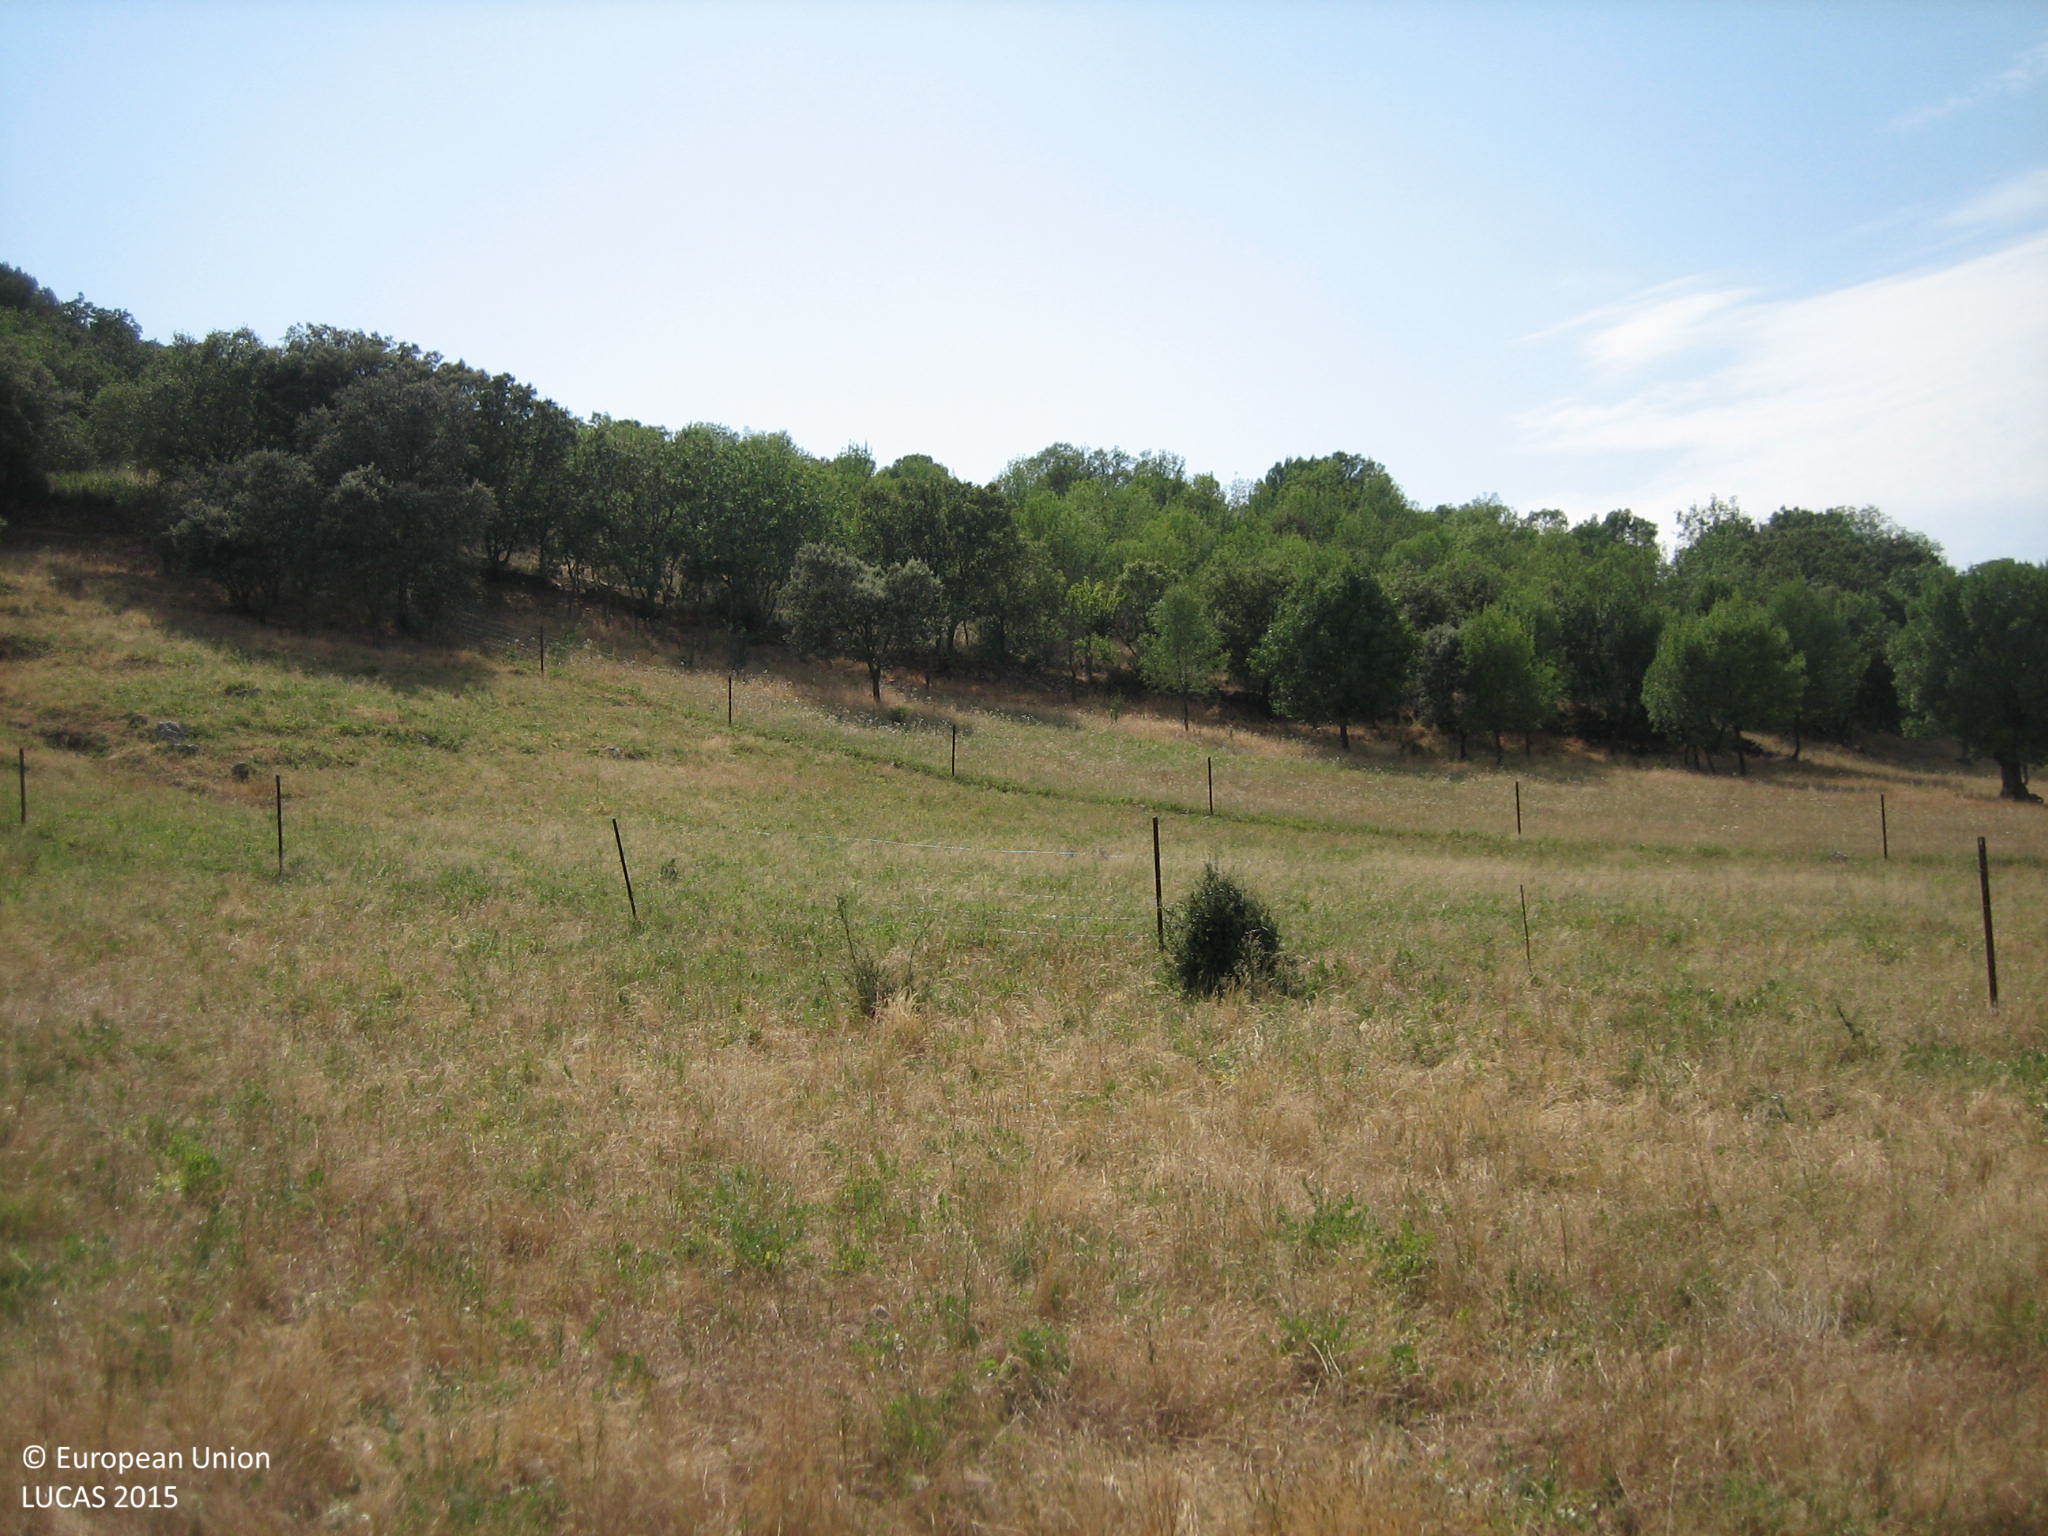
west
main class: Grassland
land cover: Spontaneously vegetated surfaces
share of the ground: > 75 %
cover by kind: herbaceous plants 100 %
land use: Fallow land
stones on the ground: < 10 %
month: June
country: ES
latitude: 39.3245
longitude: -4.7808
